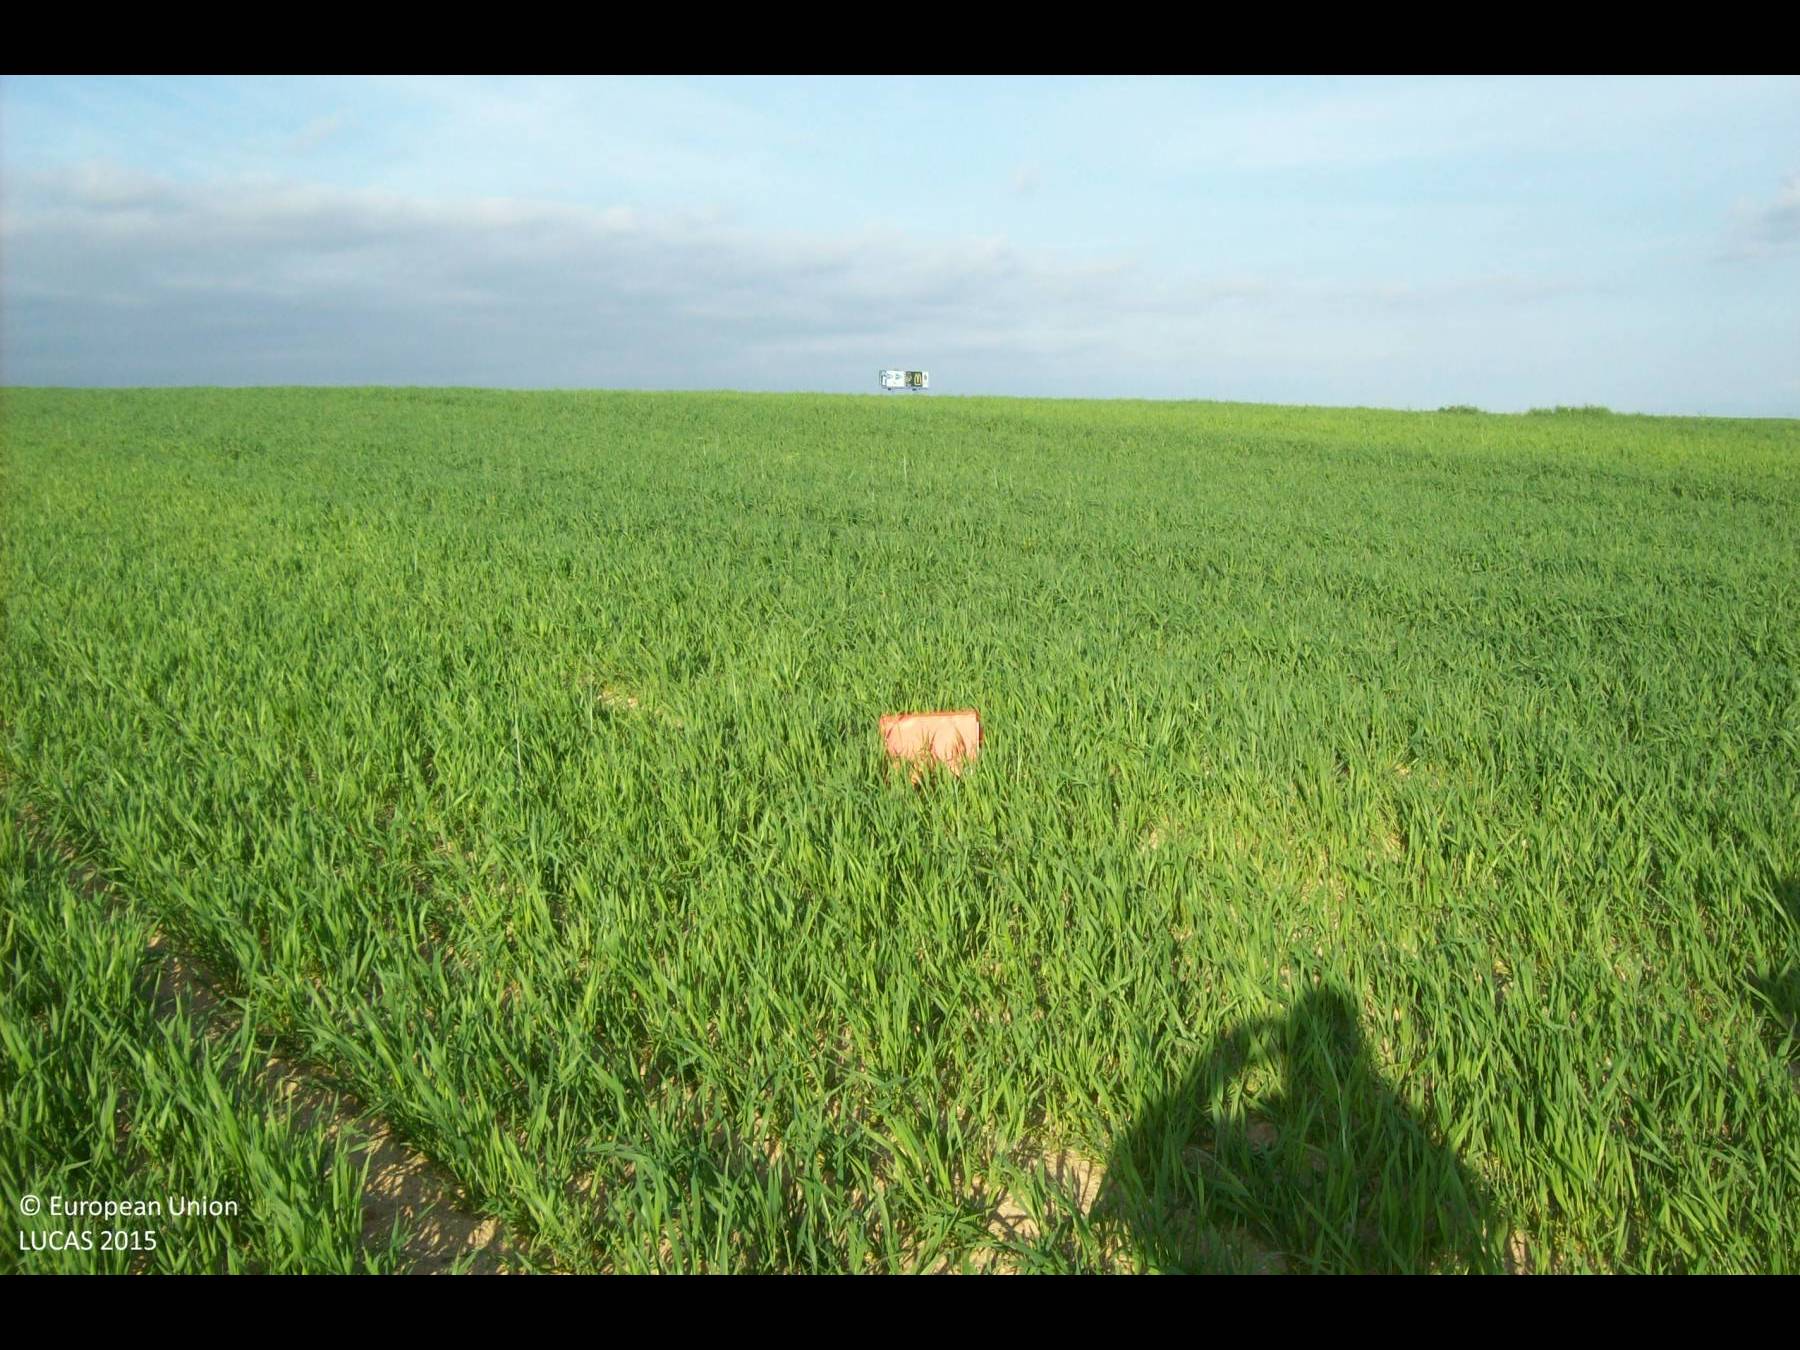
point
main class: Cropland
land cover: Barley
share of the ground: > 75 %
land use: Agriculture (excluding fallow land and kitchen gardens)
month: April
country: ES
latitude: 40.3186
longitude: -3.8899
